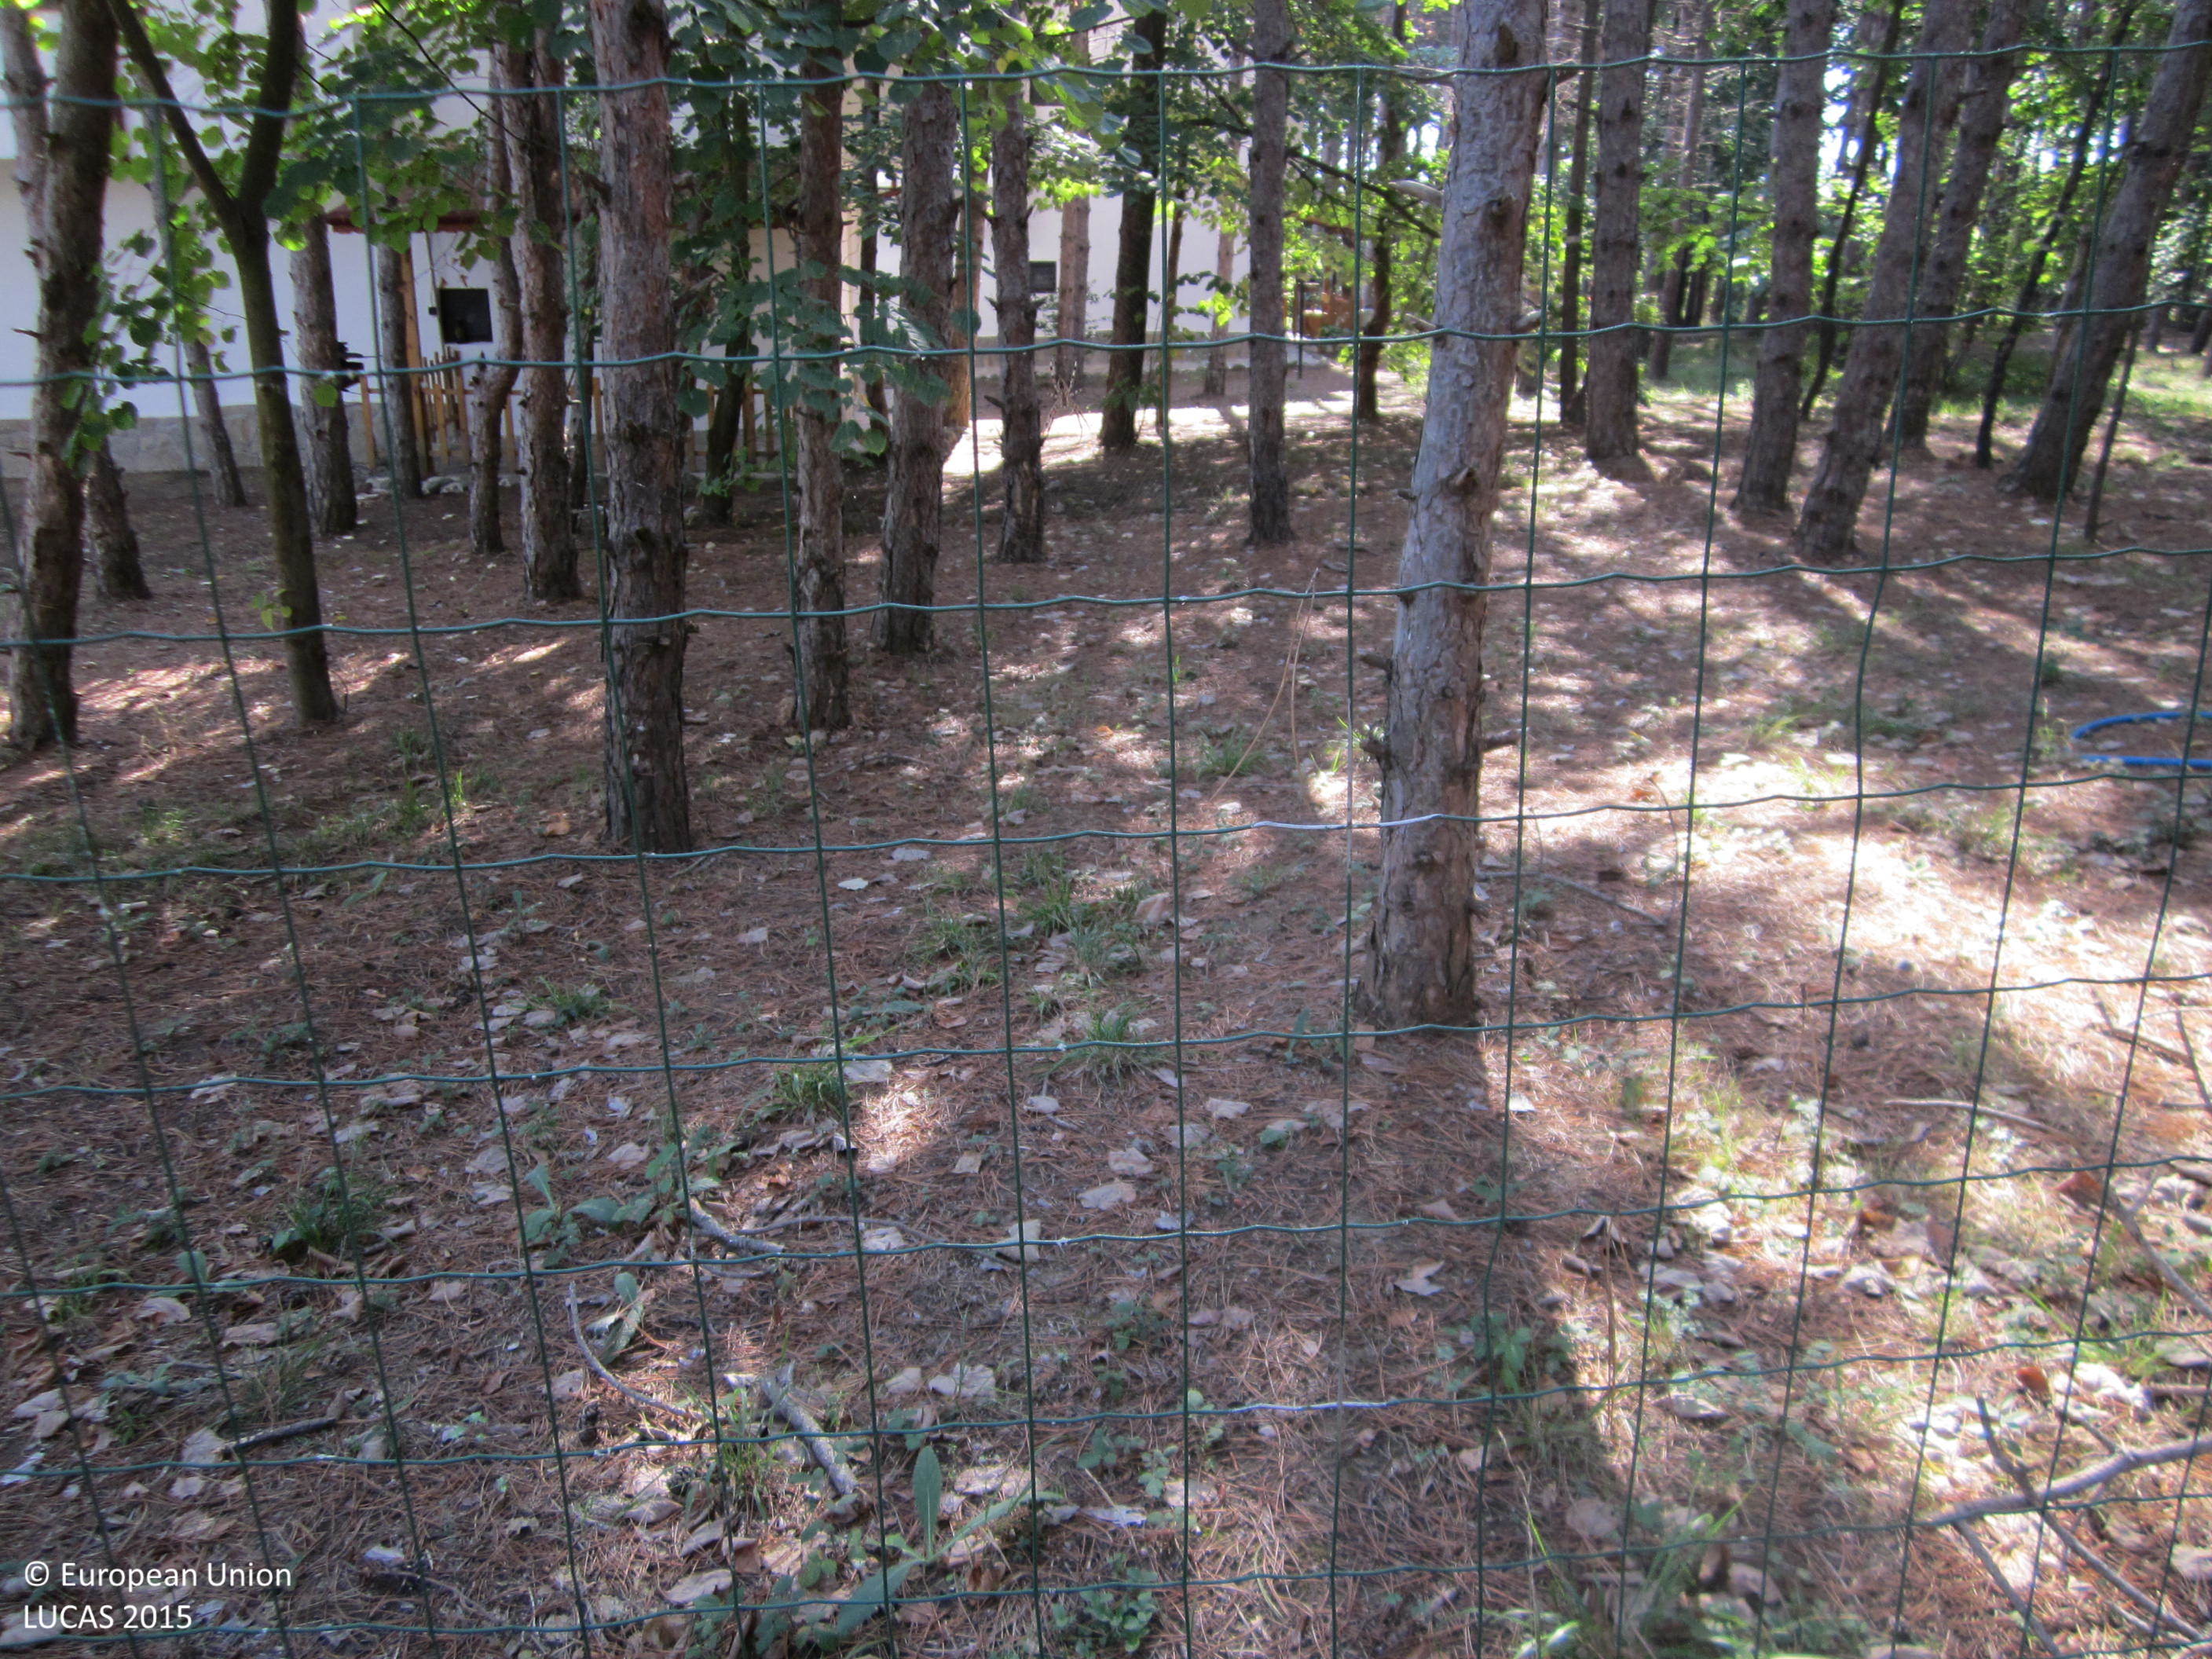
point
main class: Woodland
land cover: Pine dominated mixed woodland
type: acidophilous oak and oak-birch forest
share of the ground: > 75 %
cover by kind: coniferous forest trees 60 %, broadleaved forest trees 20 %, unconsolidated bare surface 20 %
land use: Forestry
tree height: > 5 m
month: September
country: BG
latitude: 42.1813
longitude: 27.8354
